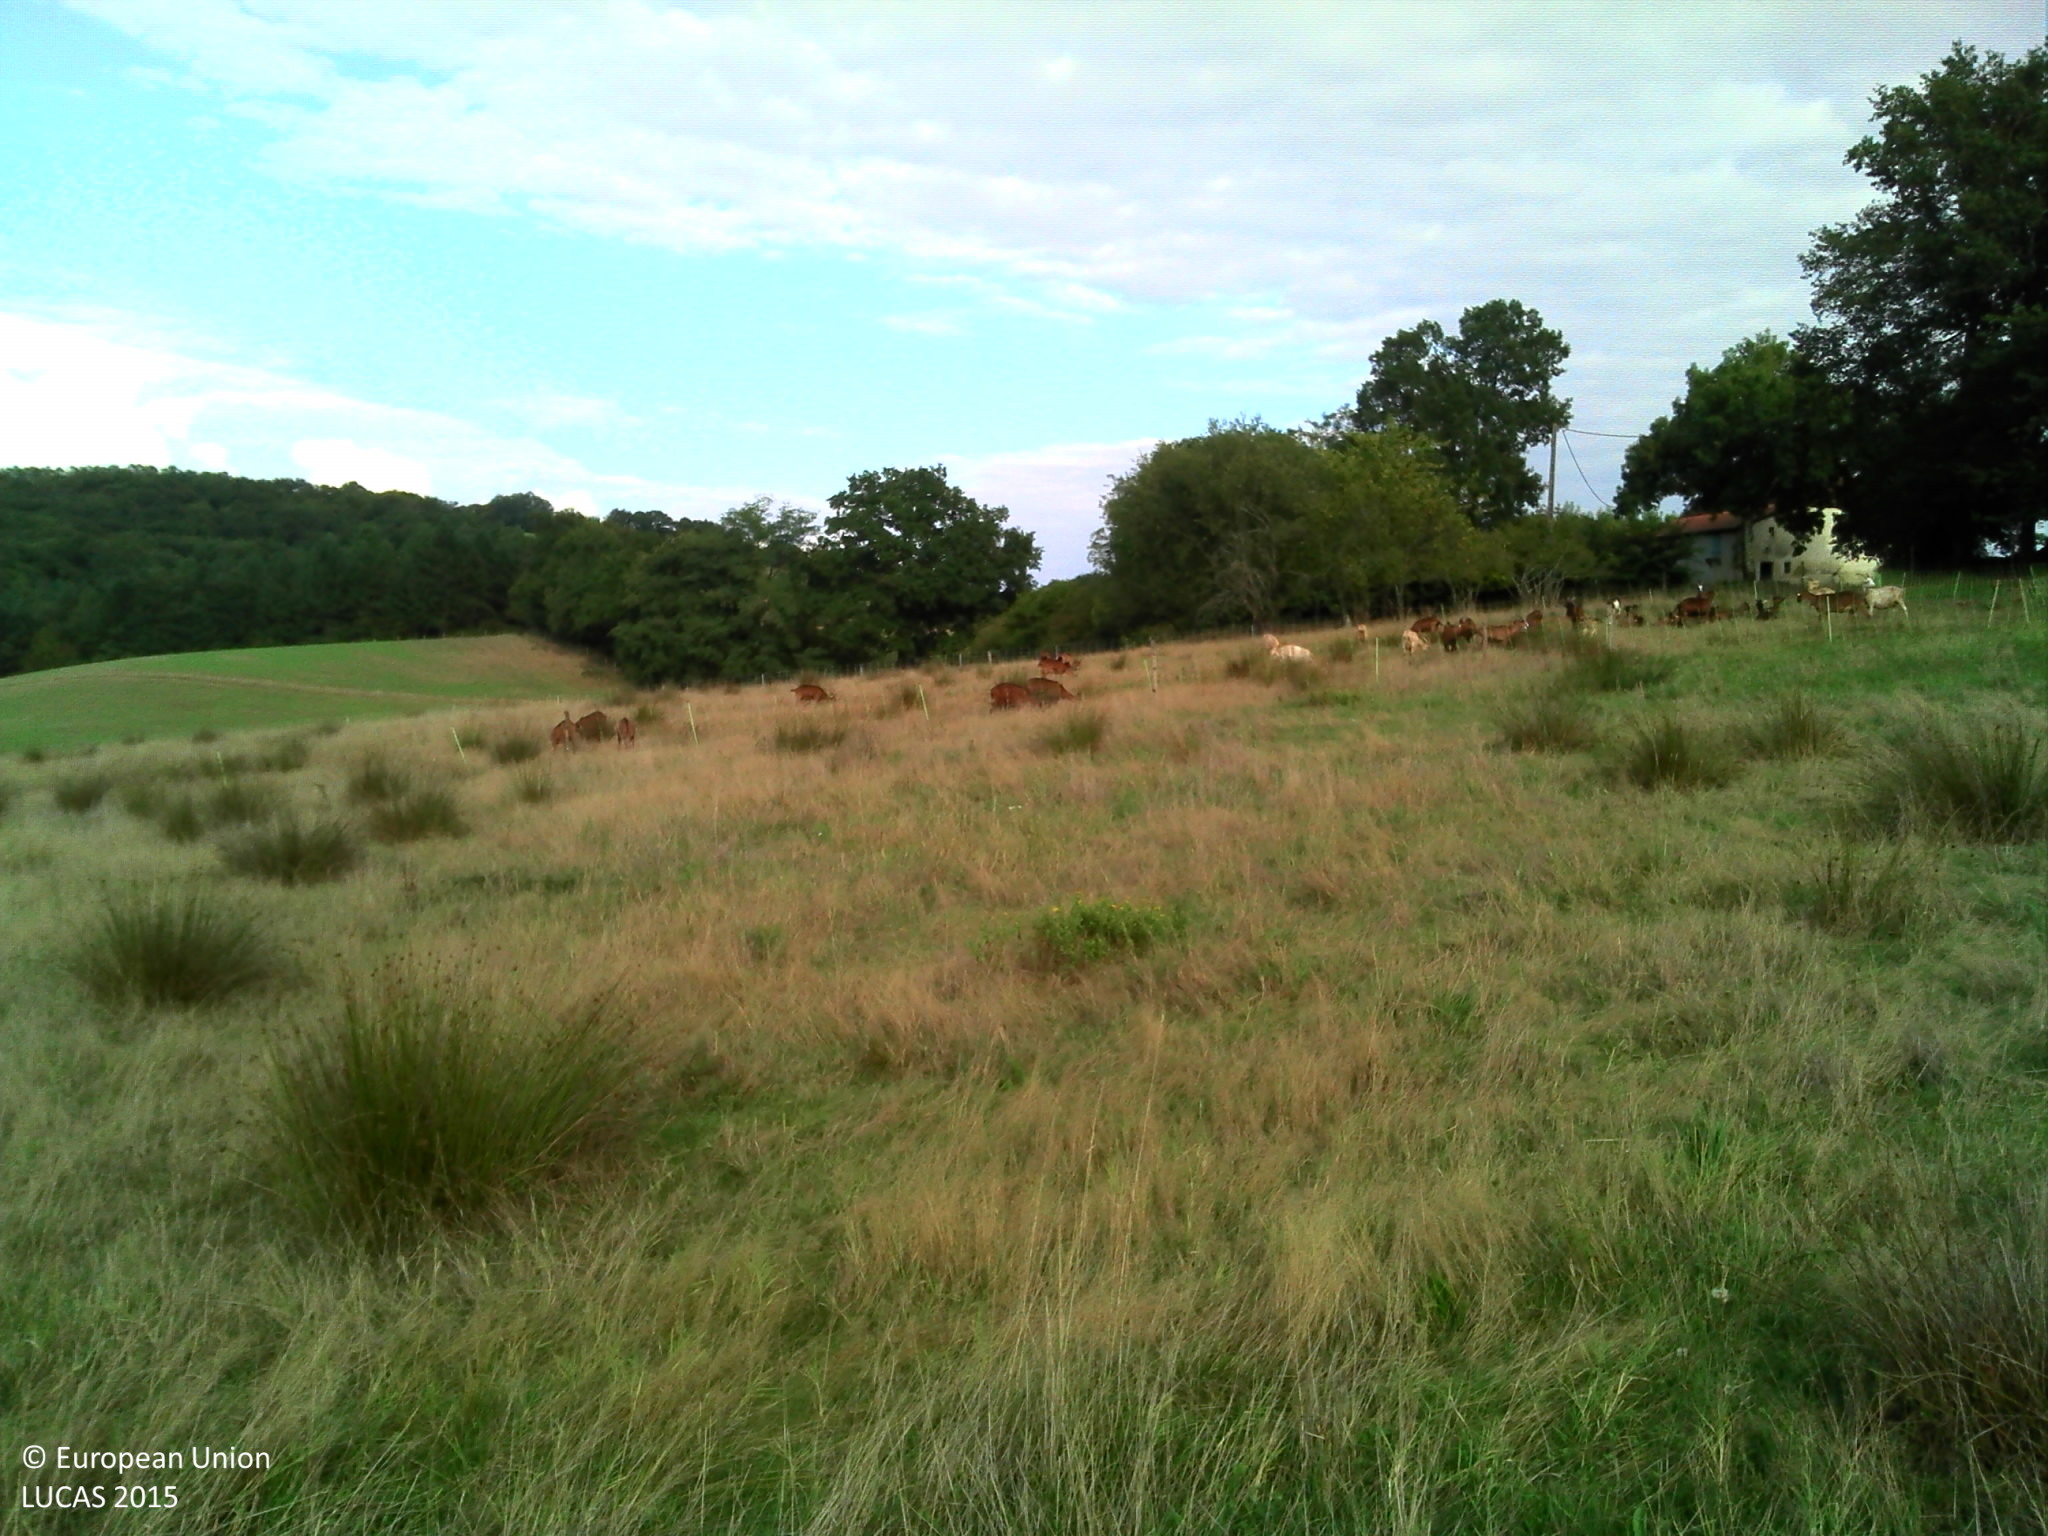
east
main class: Grassland
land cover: Grassland without tree/shrub cover
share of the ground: > 75 %
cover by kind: herbaceous plants 100 %
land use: Agriculture (excluding fallow land and kitchen gardens)
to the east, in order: Grassland without tree/shrub cover; Fences; Grassland without tree/shrub cover; Fences; Single bushes/trees; Grassland without tree/shrub cover; Broadleaved woodland; Tracks; Broadleaved woodland; Fences; Spontaneously vegetated surfaces; Grassland without tree/shrub cover; Fences; Tracks; Single bushes/trees; Grassland without tree/shrub cover; Fences; Grassland without tree/shrub cover; Fences; Grassland with sparse tree/shrub cover
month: September
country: FR
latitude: 43.5216
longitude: -0.5382
